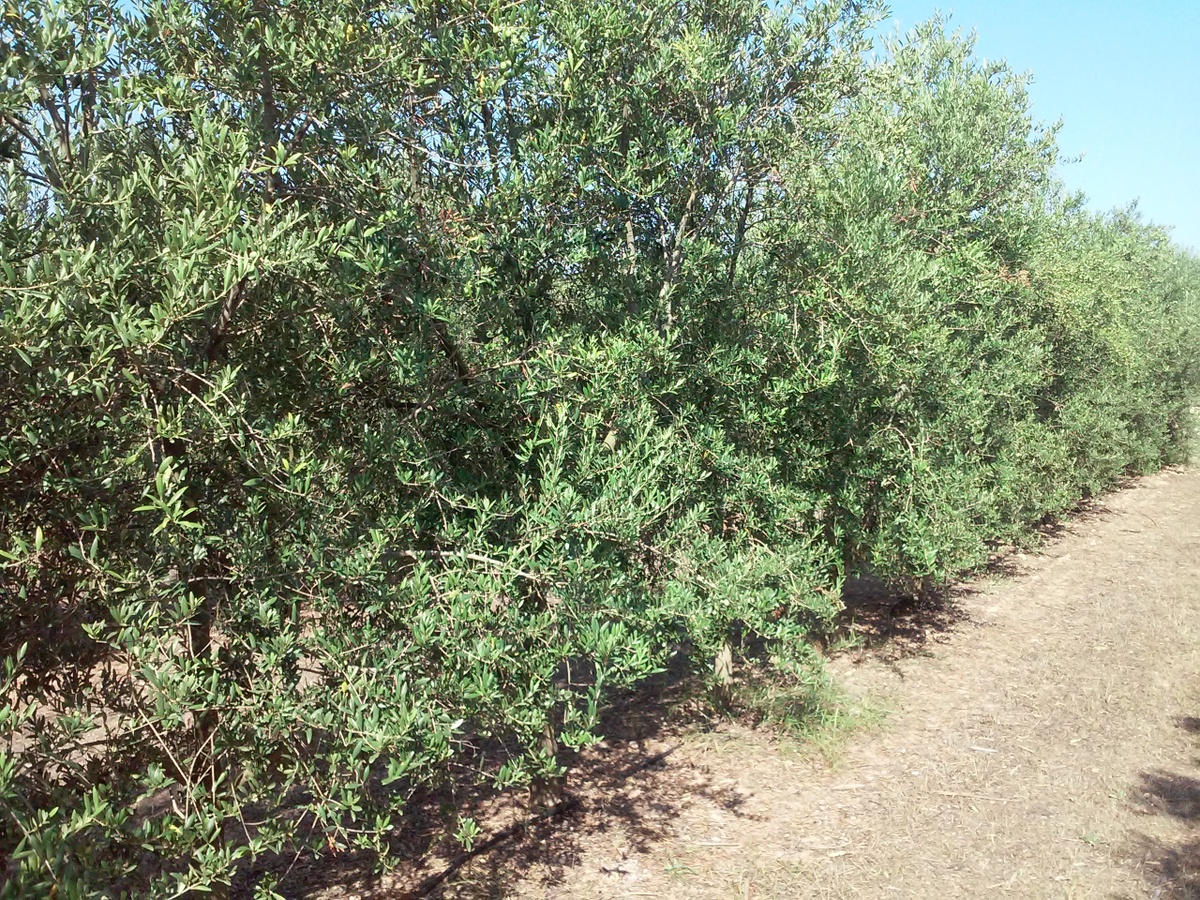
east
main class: Cropland
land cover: Olive groves
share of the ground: 10 - 25 %
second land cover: Other bare soil
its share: > 75 %
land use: Agriculture (excluding fallow land and kitchen gardens)
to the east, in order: Olive groves; Other bare soil; Shruby margins; Fences; Tracks; Olive groves; Fences; Tracks; Nuts trees; Grass margins; Tracks; Nuts trees; Tracks; Nuts trees
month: August
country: ES
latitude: 41.0911
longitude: 0.6228
